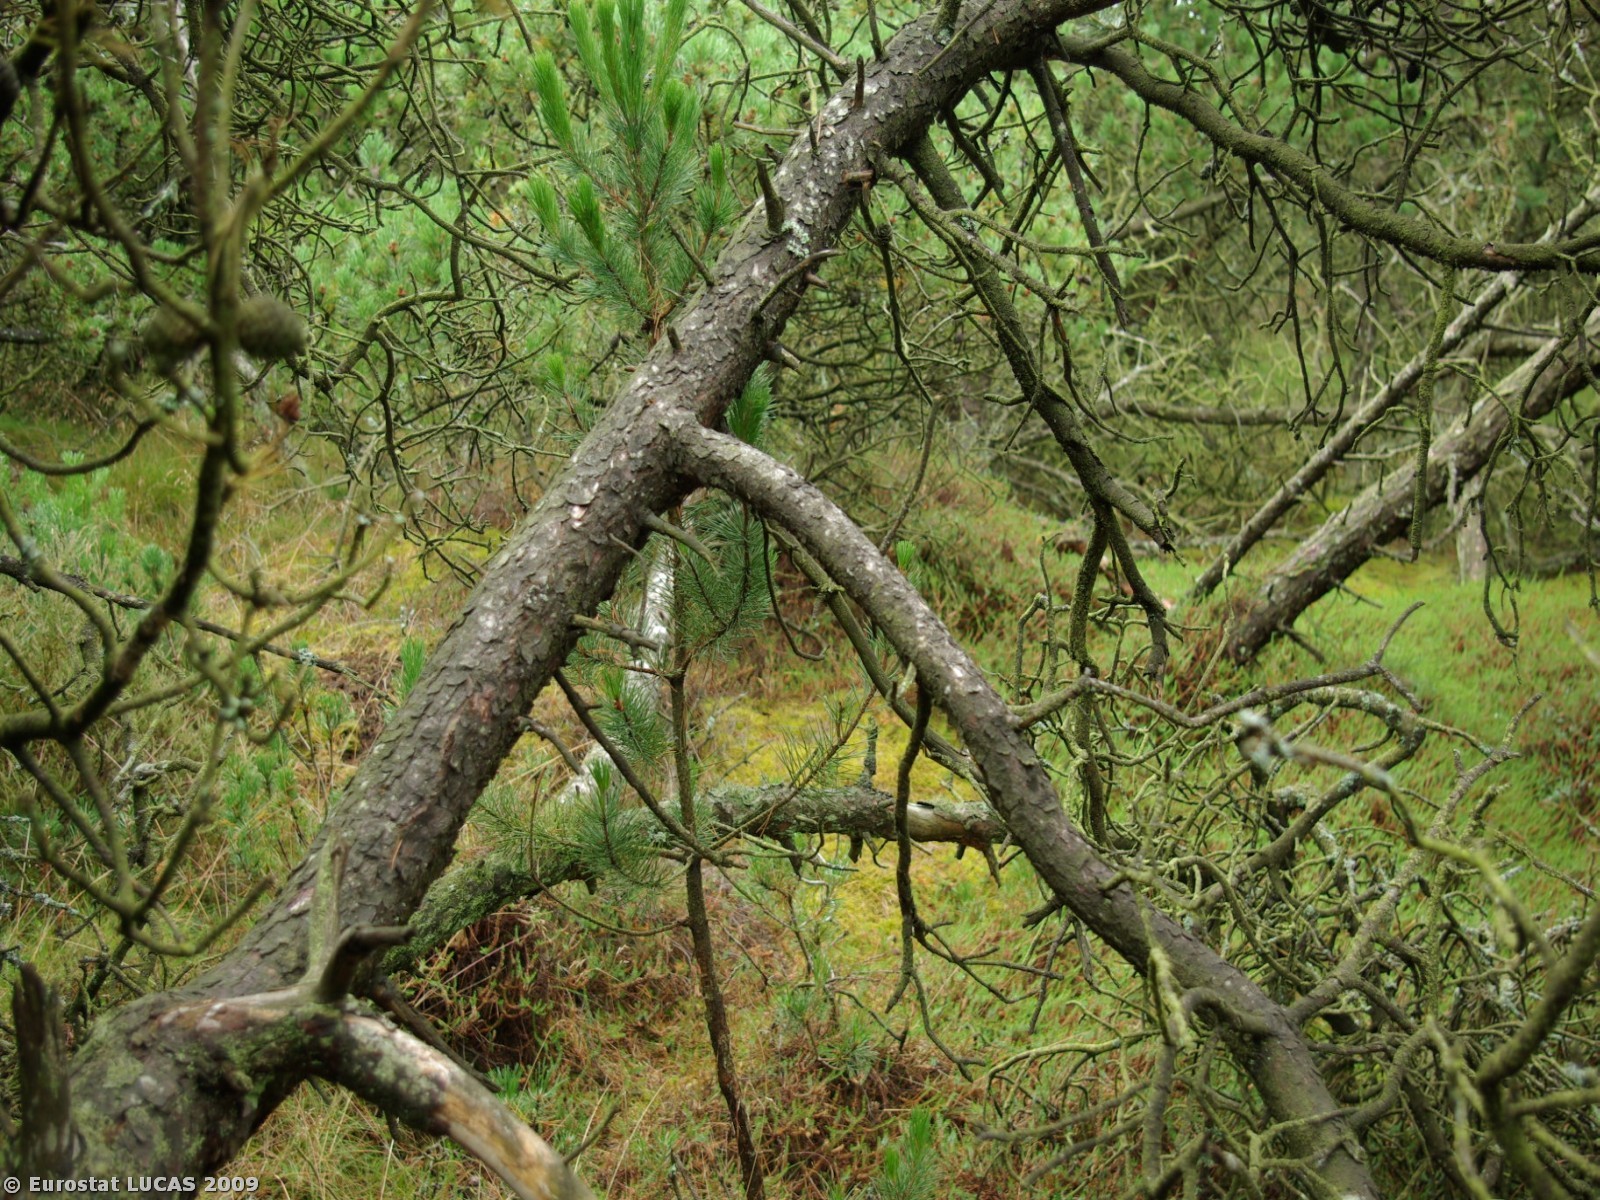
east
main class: Woodland
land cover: Coniferous woodland
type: hemiboreal forest and nemoral coniferous forest and mixed broadleaved-coniferous forest
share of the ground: > 75 %
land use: Unused
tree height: > 5 m
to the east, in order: Coniferous woodland; Tracks; Coniferous woodland; Shrubland with sparse tree cover; Spontaneously vegetated surfaces; Tracks; Spontaneously vegetated surfaces; Ditches and canals; Shrubland without tree cover; Ditches and canals; Spontaneously vegetated surfaces; Paved roads, cycling and walking lanes; Spontaneously vegetated surfaces; Ditches and canals; Shrubland without tree cover; Fences; Shrubland without tree cover
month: July
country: DK
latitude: 55.1188
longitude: 8.5429
